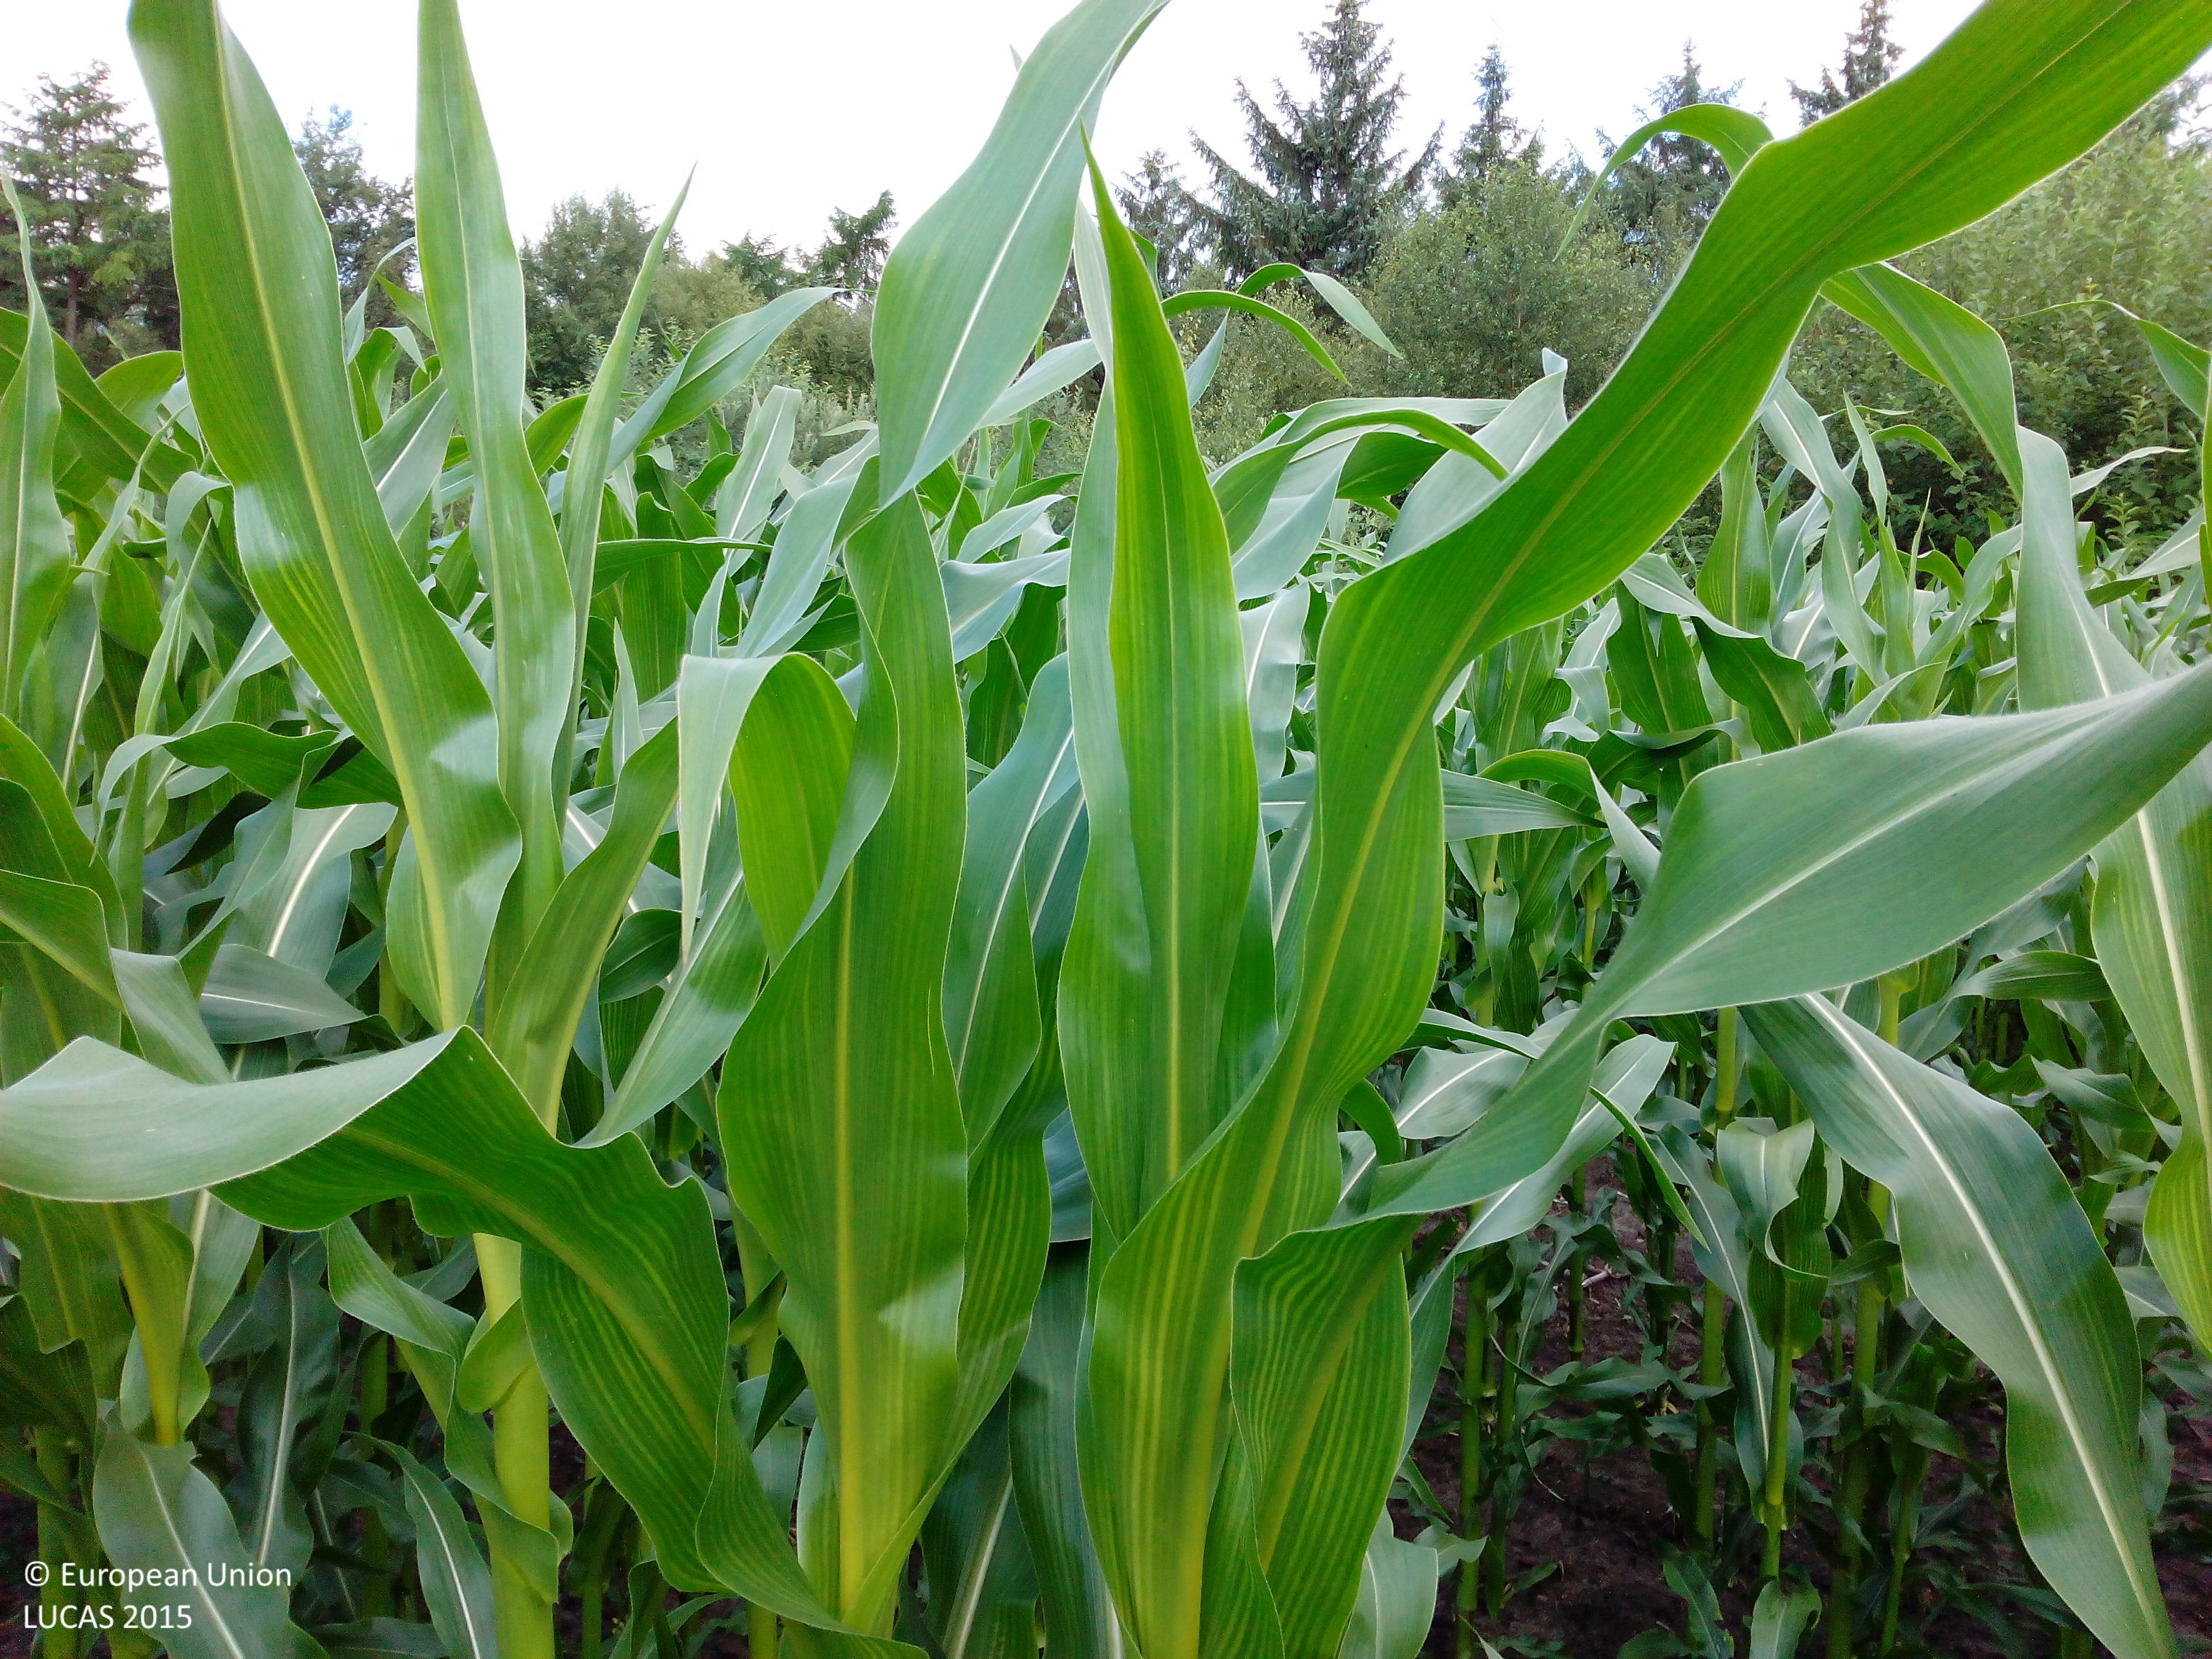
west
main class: Cropland
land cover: Maize
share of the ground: > 75 %
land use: Agriculture (excluding fallow land and kitchen gardens)
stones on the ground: < 10 %
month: July
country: DE
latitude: 53.0257
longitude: 7.9878
